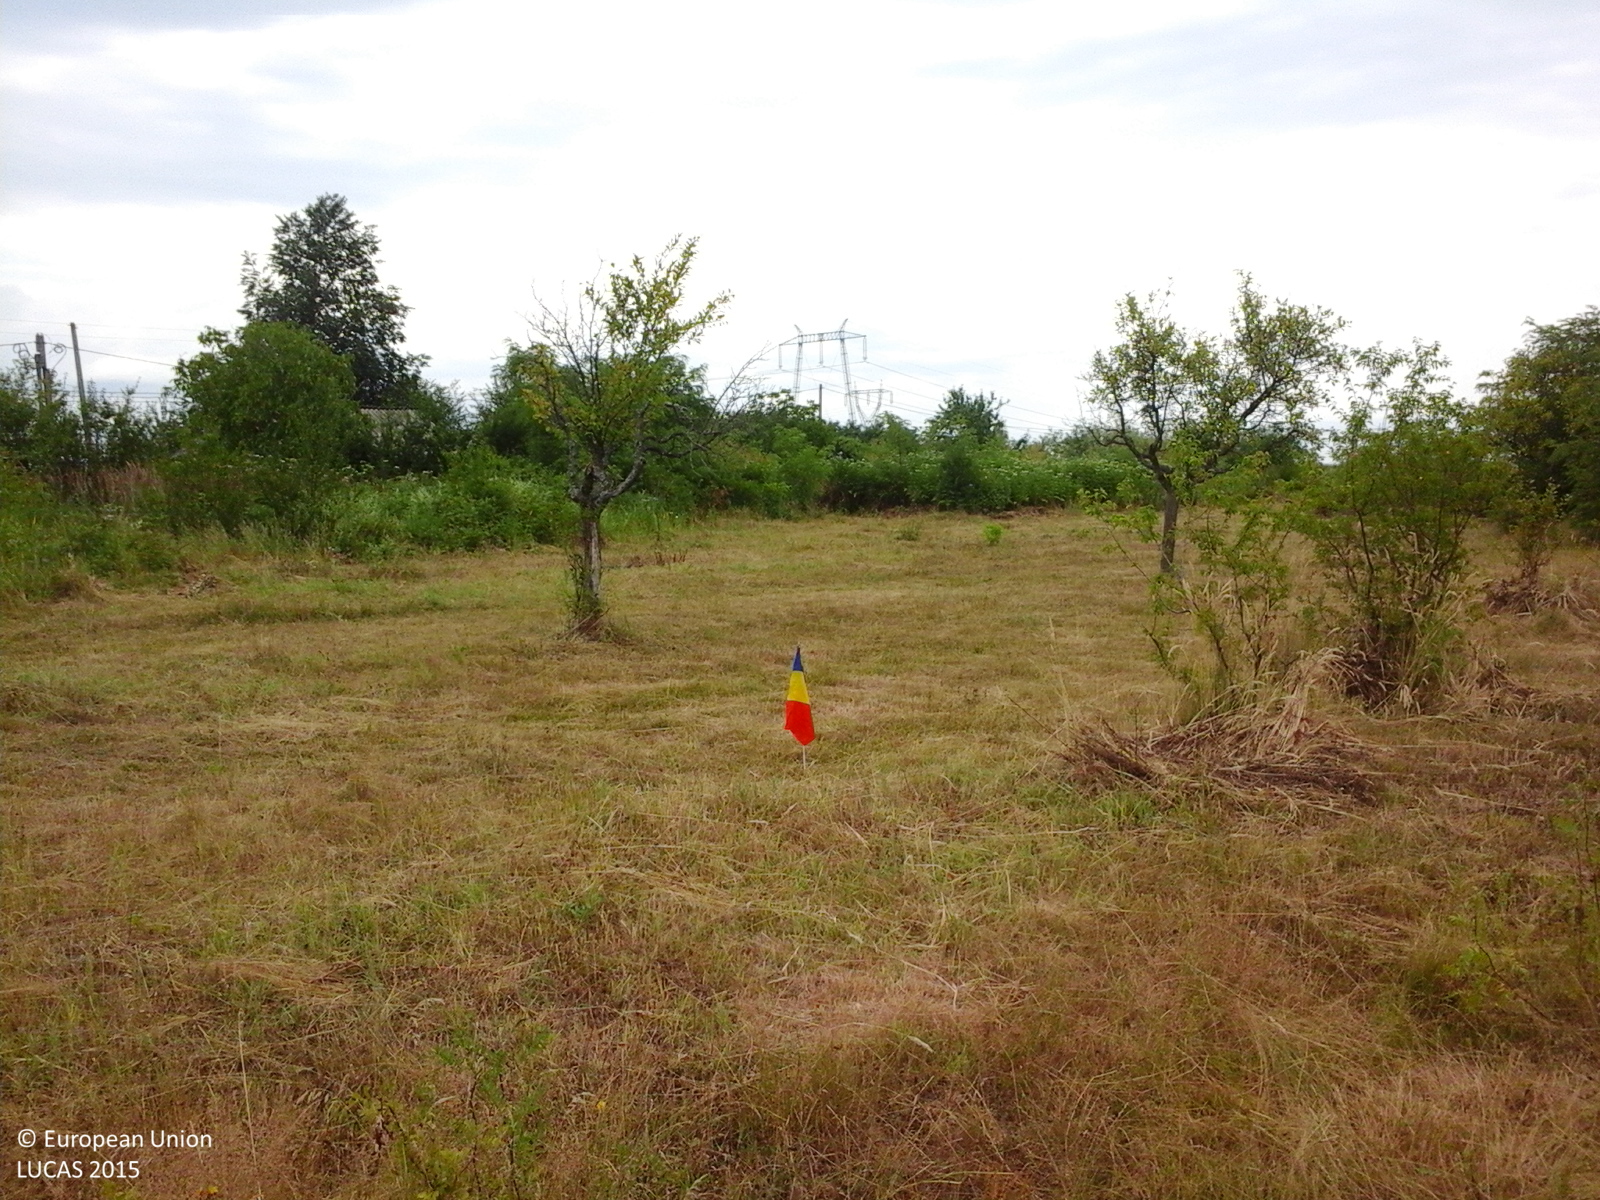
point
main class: Cropland
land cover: Other fruit trees and berries
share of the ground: > 75 %
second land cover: Grassland without tree/shrub cover
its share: > 75 %
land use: Agriculture (excluding fallow land and kitchen gardens)
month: July
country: RO
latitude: 44.8007
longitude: 24.4210
